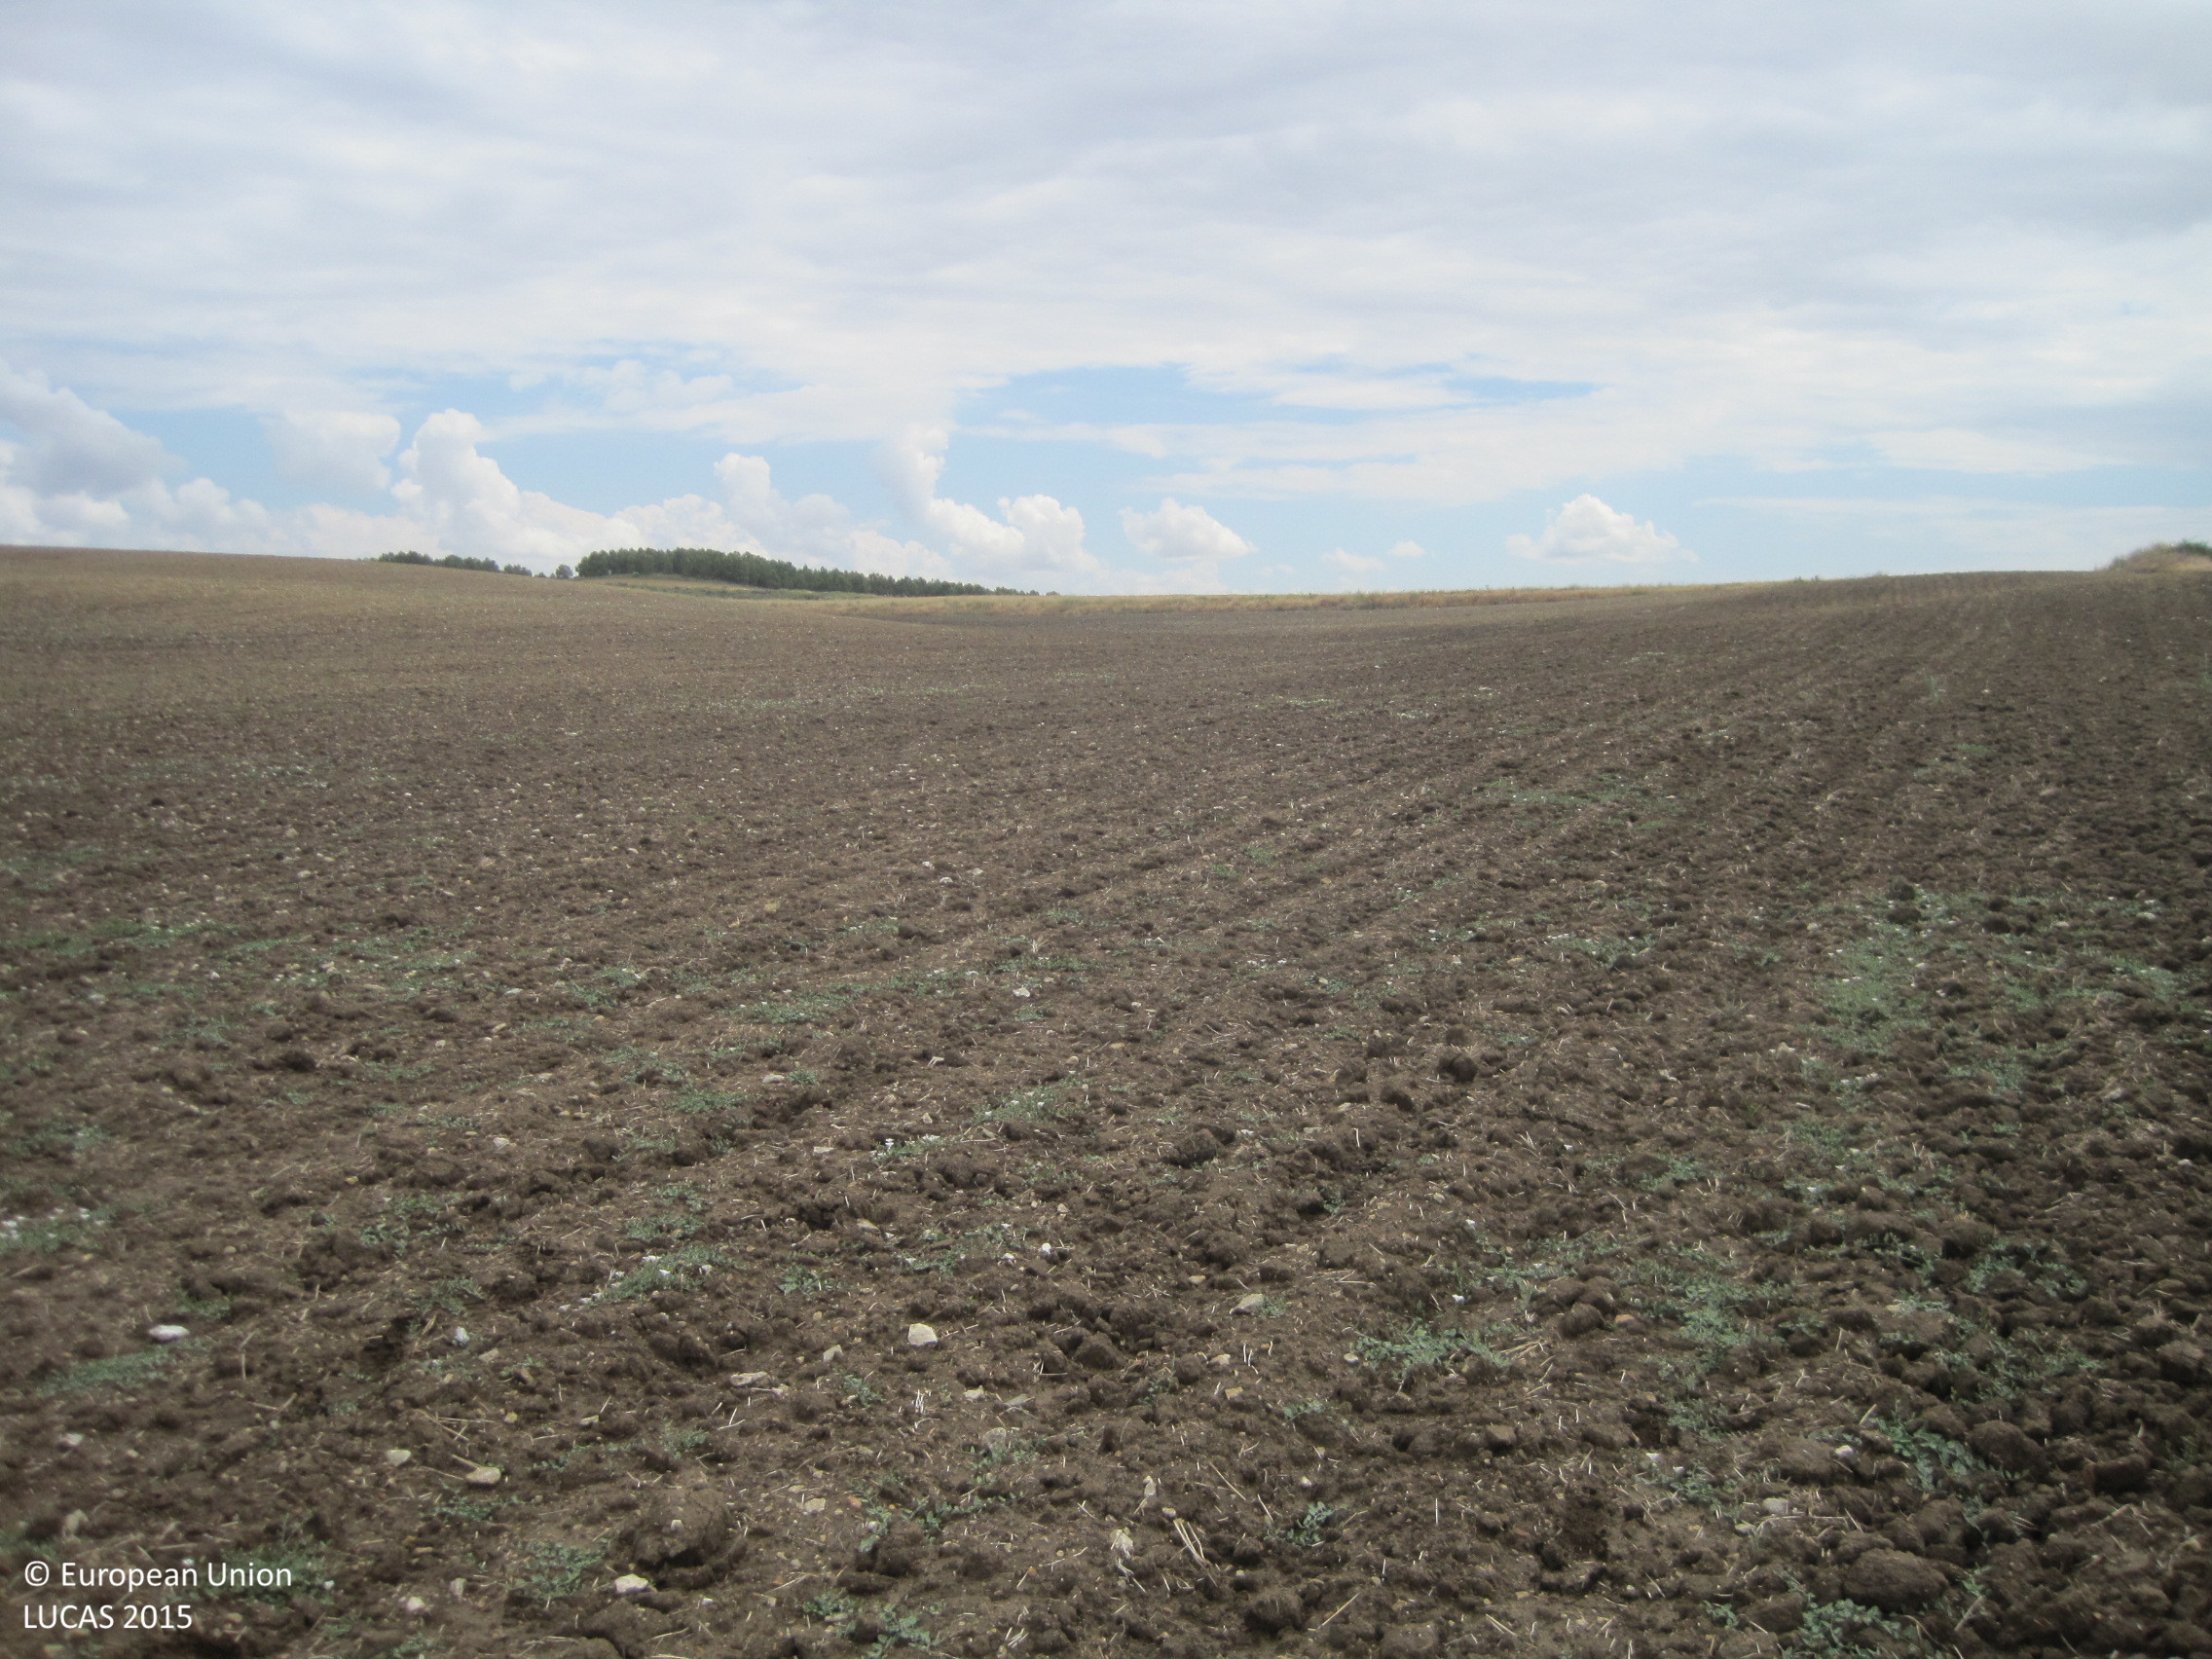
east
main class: Grassland
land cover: Spontaneously vegetated surfaces
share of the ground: 10 - 25 %
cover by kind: unconsolidated bare surface 90 %, herbaceous plants 10 %
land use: Fallow land
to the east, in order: Spontaneously vegetated surfaces; Grass margins; Tracks; Grass margins; Oats
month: June
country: ES
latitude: 42.5034
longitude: -2.1500
